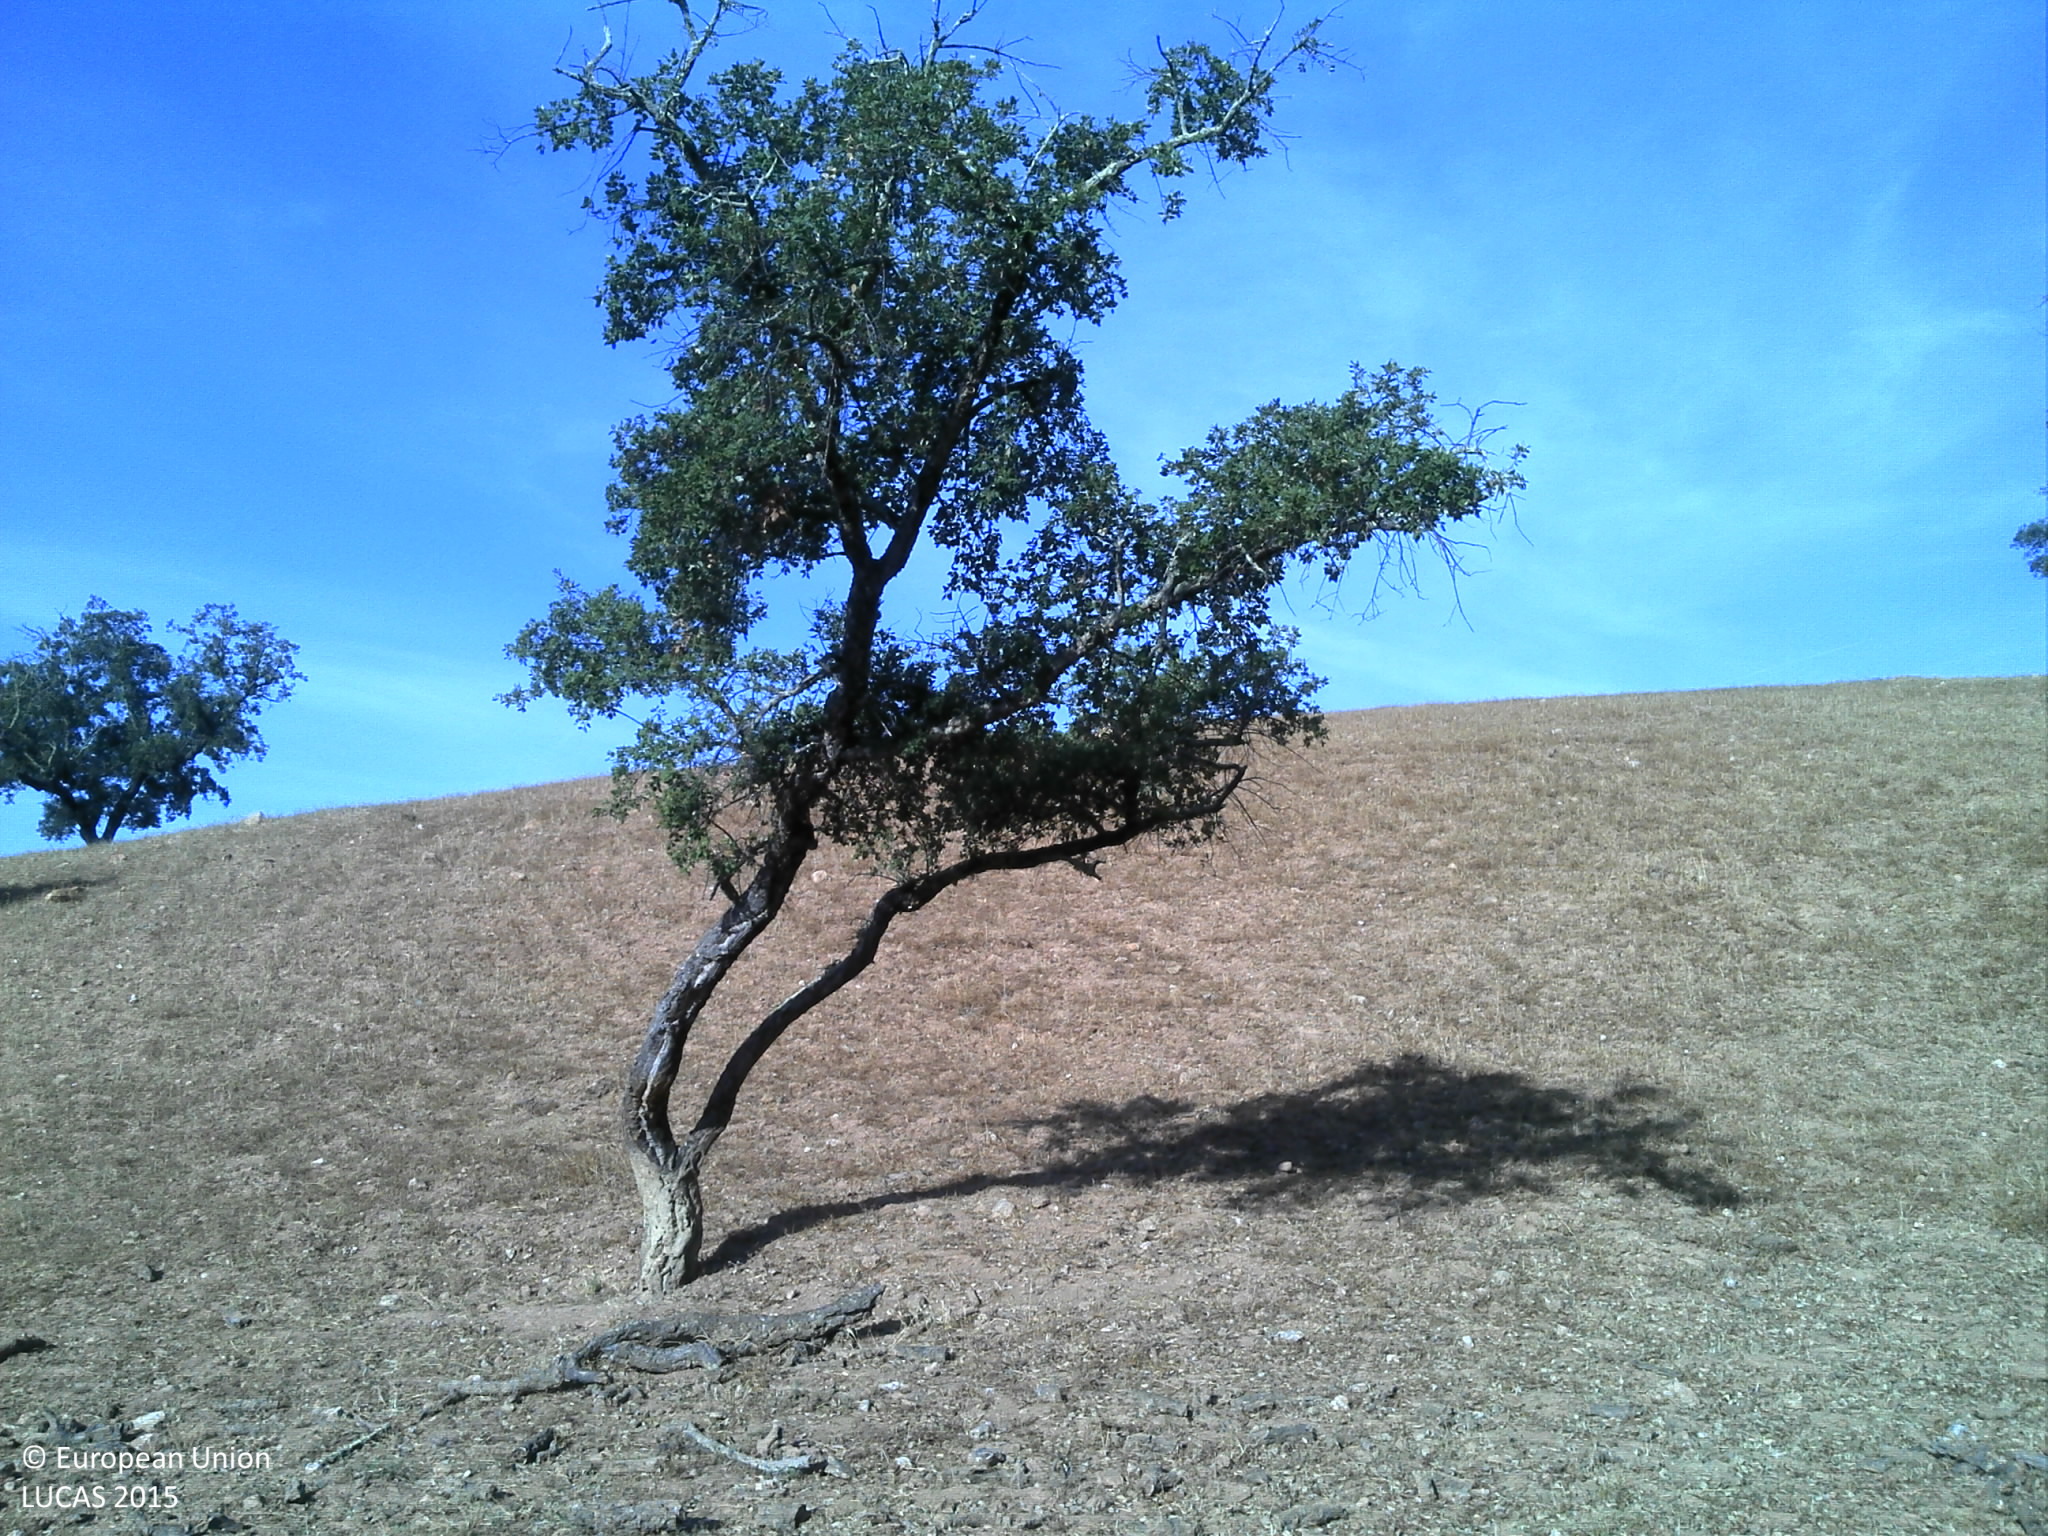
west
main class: Woodland
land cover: Broadleaved woodland
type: broadleaved evergreen forest
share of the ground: 10 - 25 %
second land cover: Grassland without tree/shrub cover
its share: 10 - 25 %
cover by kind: unconsolidated bare surface 80 %, broadleaved forest trees 10 %, herbaceous plants 10 %
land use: Forestry
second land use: Agriculture (excluding fallow land and kitchen gardens)
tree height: > 5 m
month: July
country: PT
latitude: 38.3236
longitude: -7.6321
